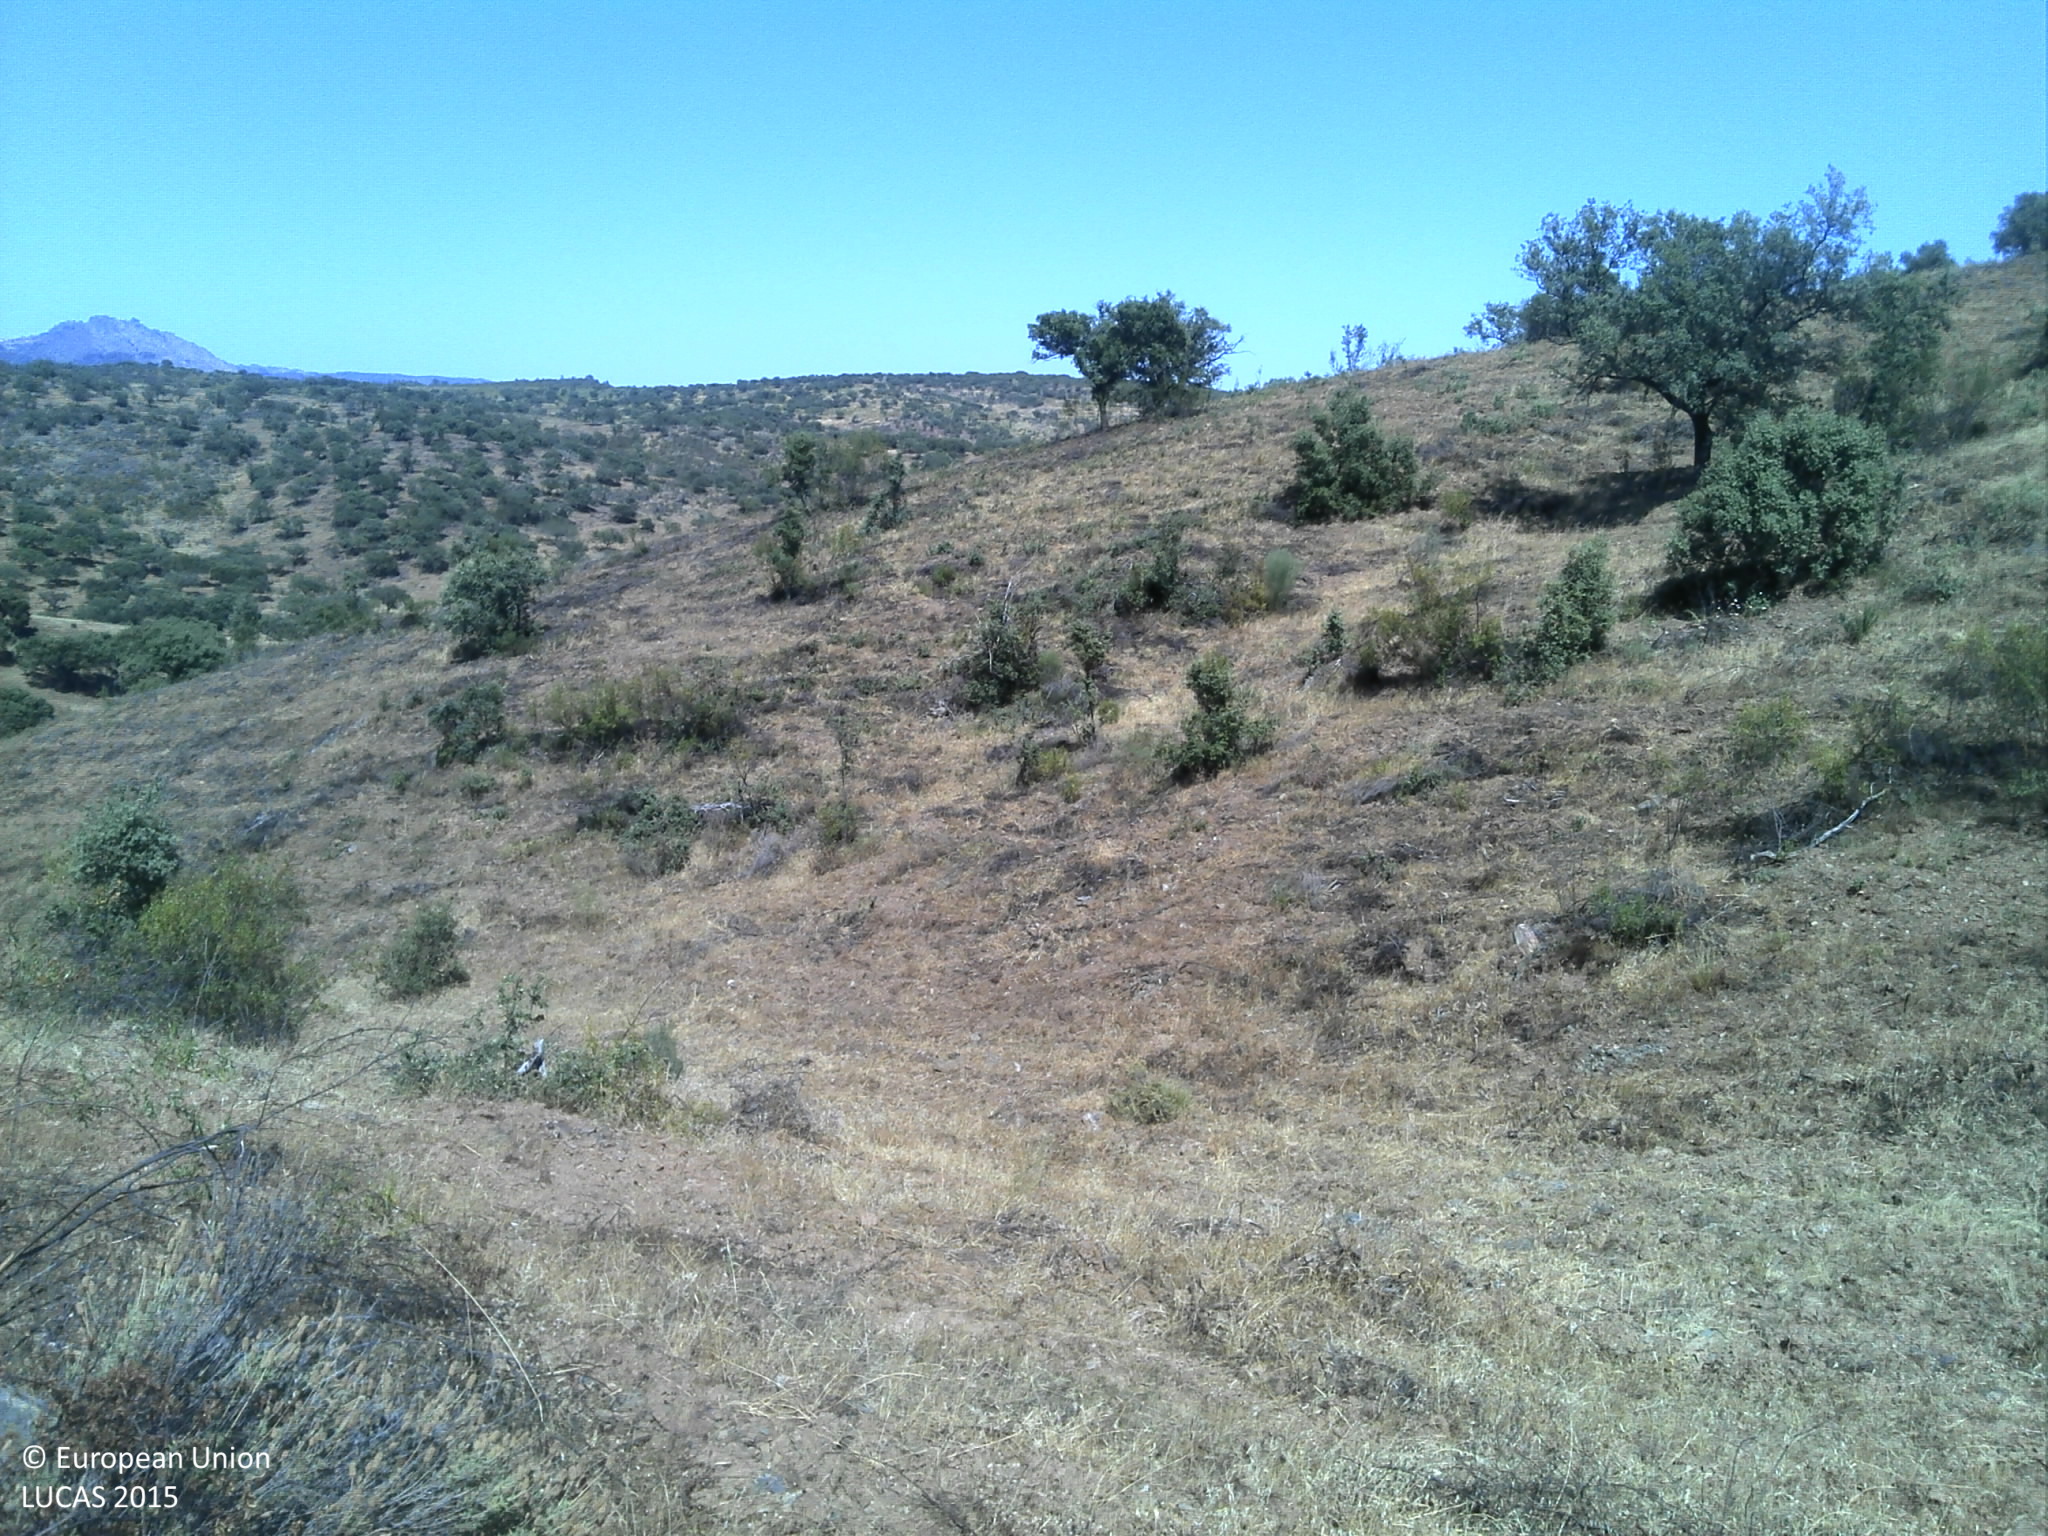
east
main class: Grassland
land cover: Grassland with sparse tree/shrub cover
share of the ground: 25 - 50 %
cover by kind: herbaceous plants 40 %, unconsolidated bare surface 40 %, broadleaved forest trees 5 %, shrubs 5 %
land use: Agriculture (excluding fallow land and kitchen gardens)
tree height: < 5 m
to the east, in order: Grassland with sparse tree/shrub cover; Tracks; Grassland with sparse tree/shrub cover
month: June
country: PT
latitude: 39.9889
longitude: -7.2054
